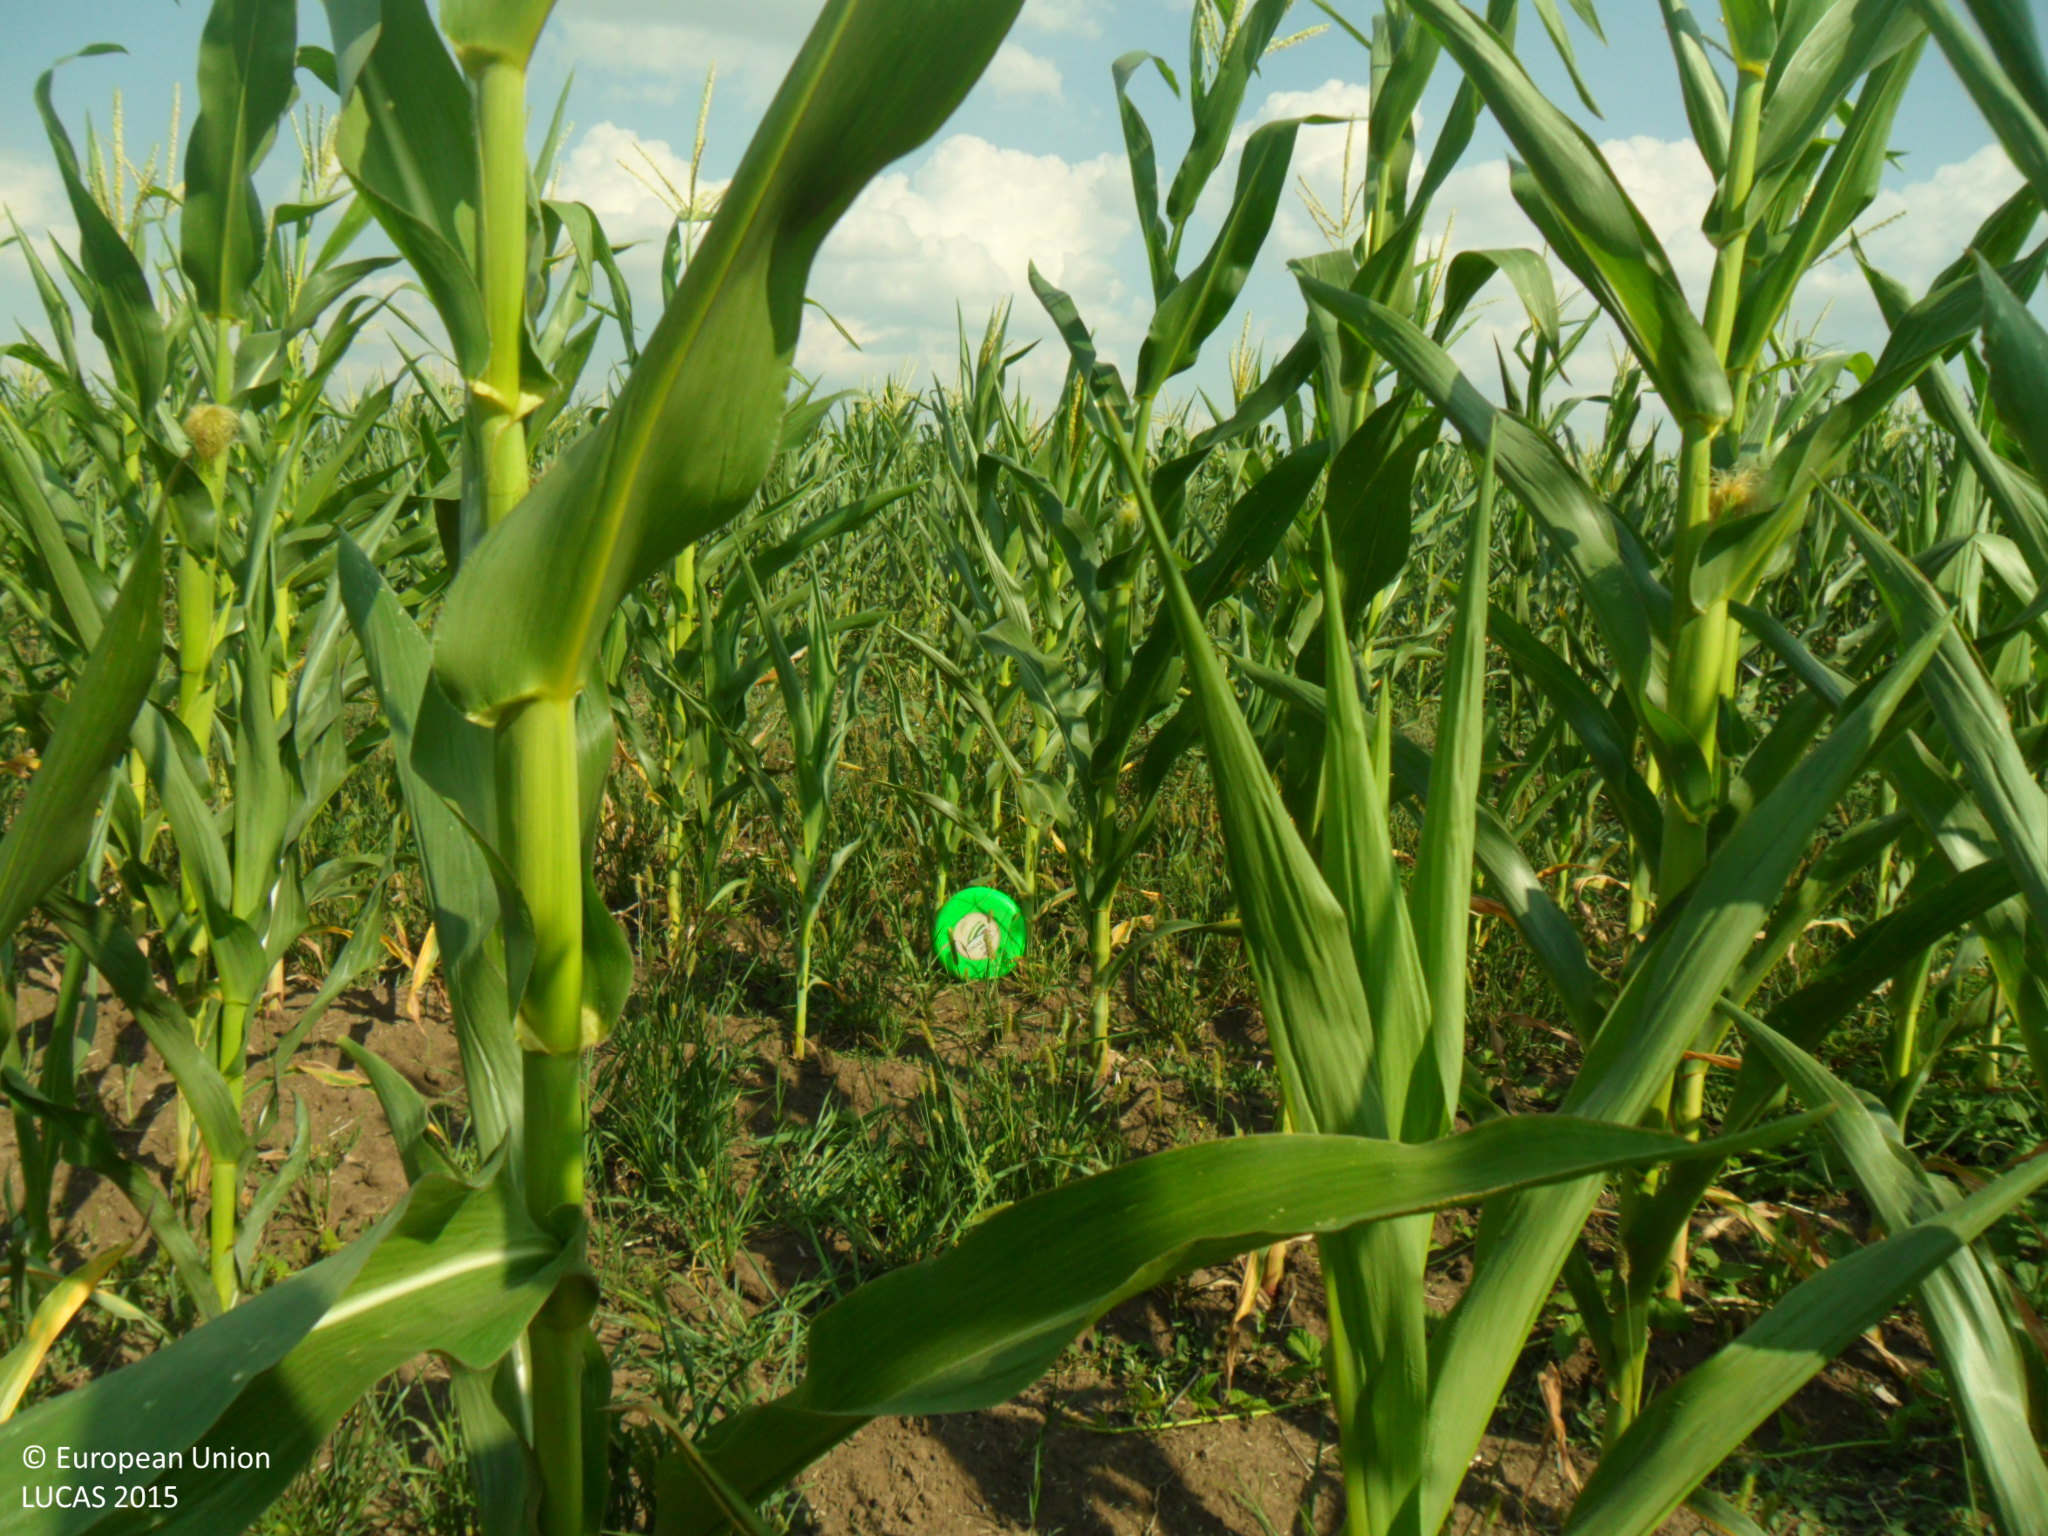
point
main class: Cropland
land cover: Maize
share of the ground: > 75 %
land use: Agriculture (excluding fallow land and kitchen gardens)
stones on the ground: < 10 %
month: July
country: BG
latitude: 43.6457
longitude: 27.0427
